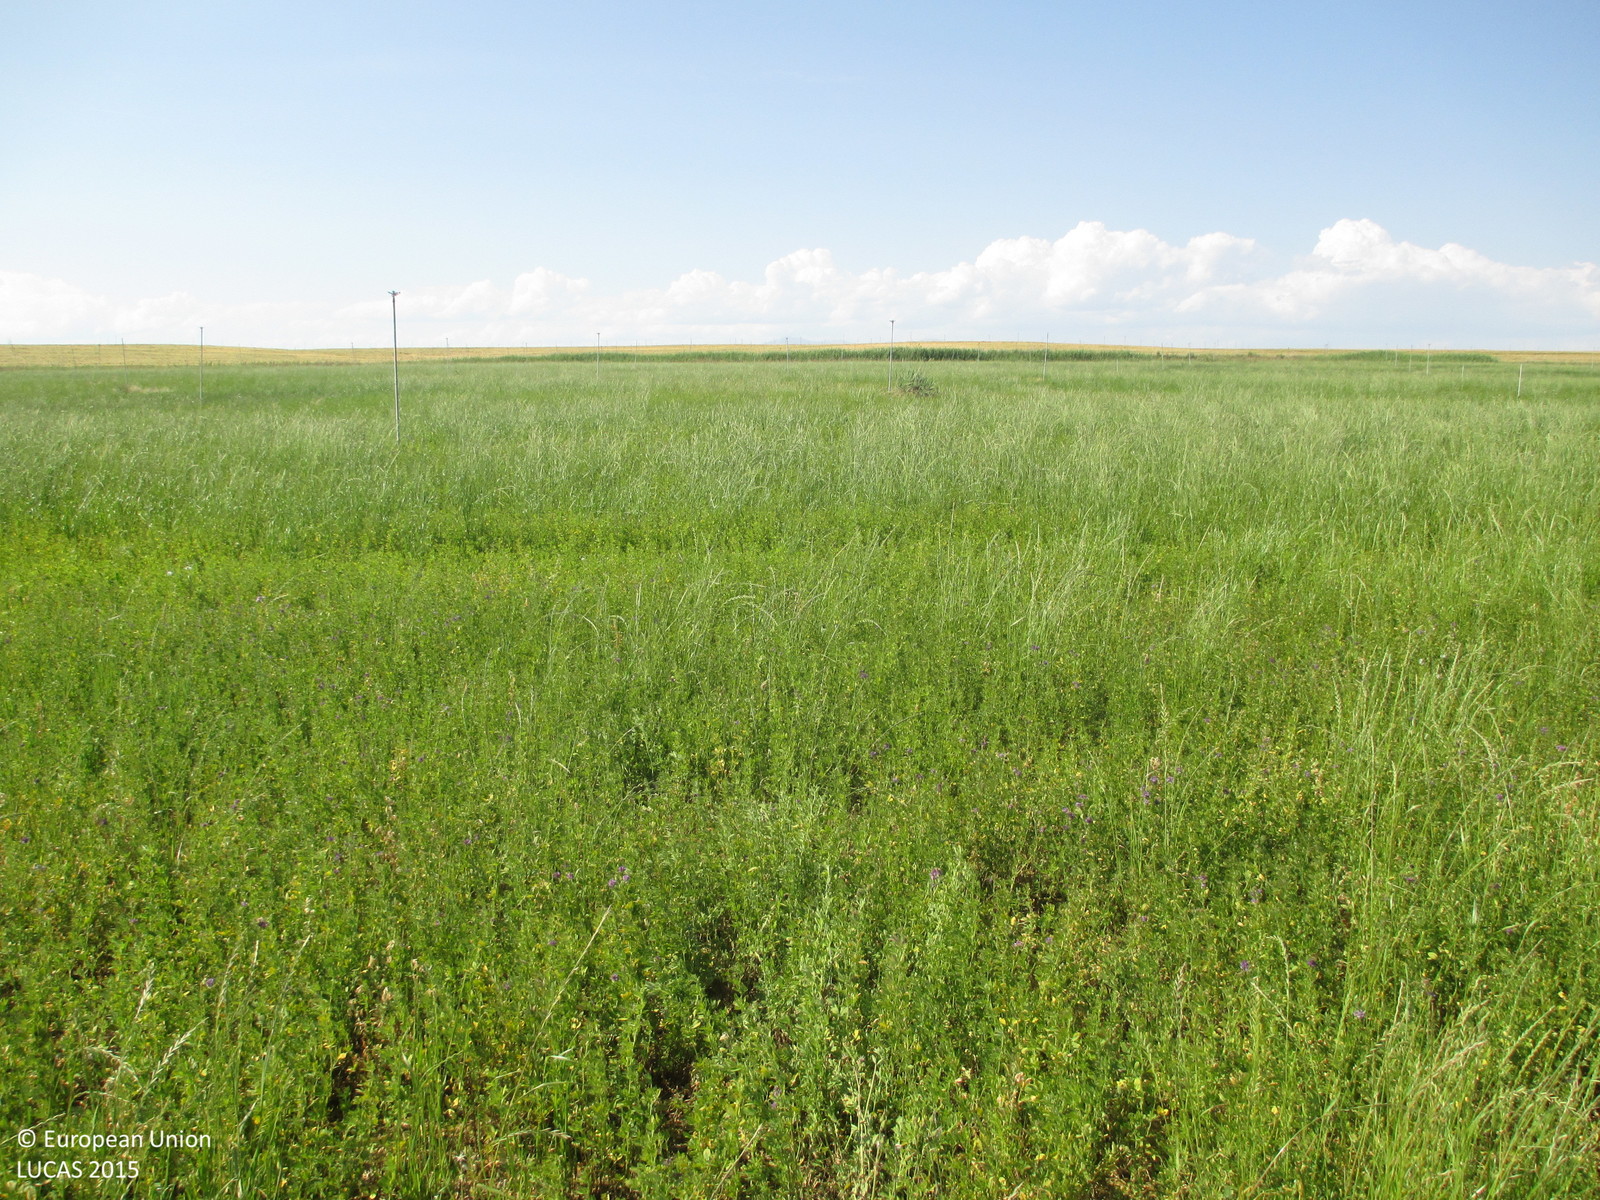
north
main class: Cropland
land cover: Lucerne
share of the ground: > 75 %
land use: Agriculture (excluding fallow land and kitchen gardens)
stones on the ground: < 10 %
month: May
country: ES
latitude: 41.9057
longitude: -0.1572
